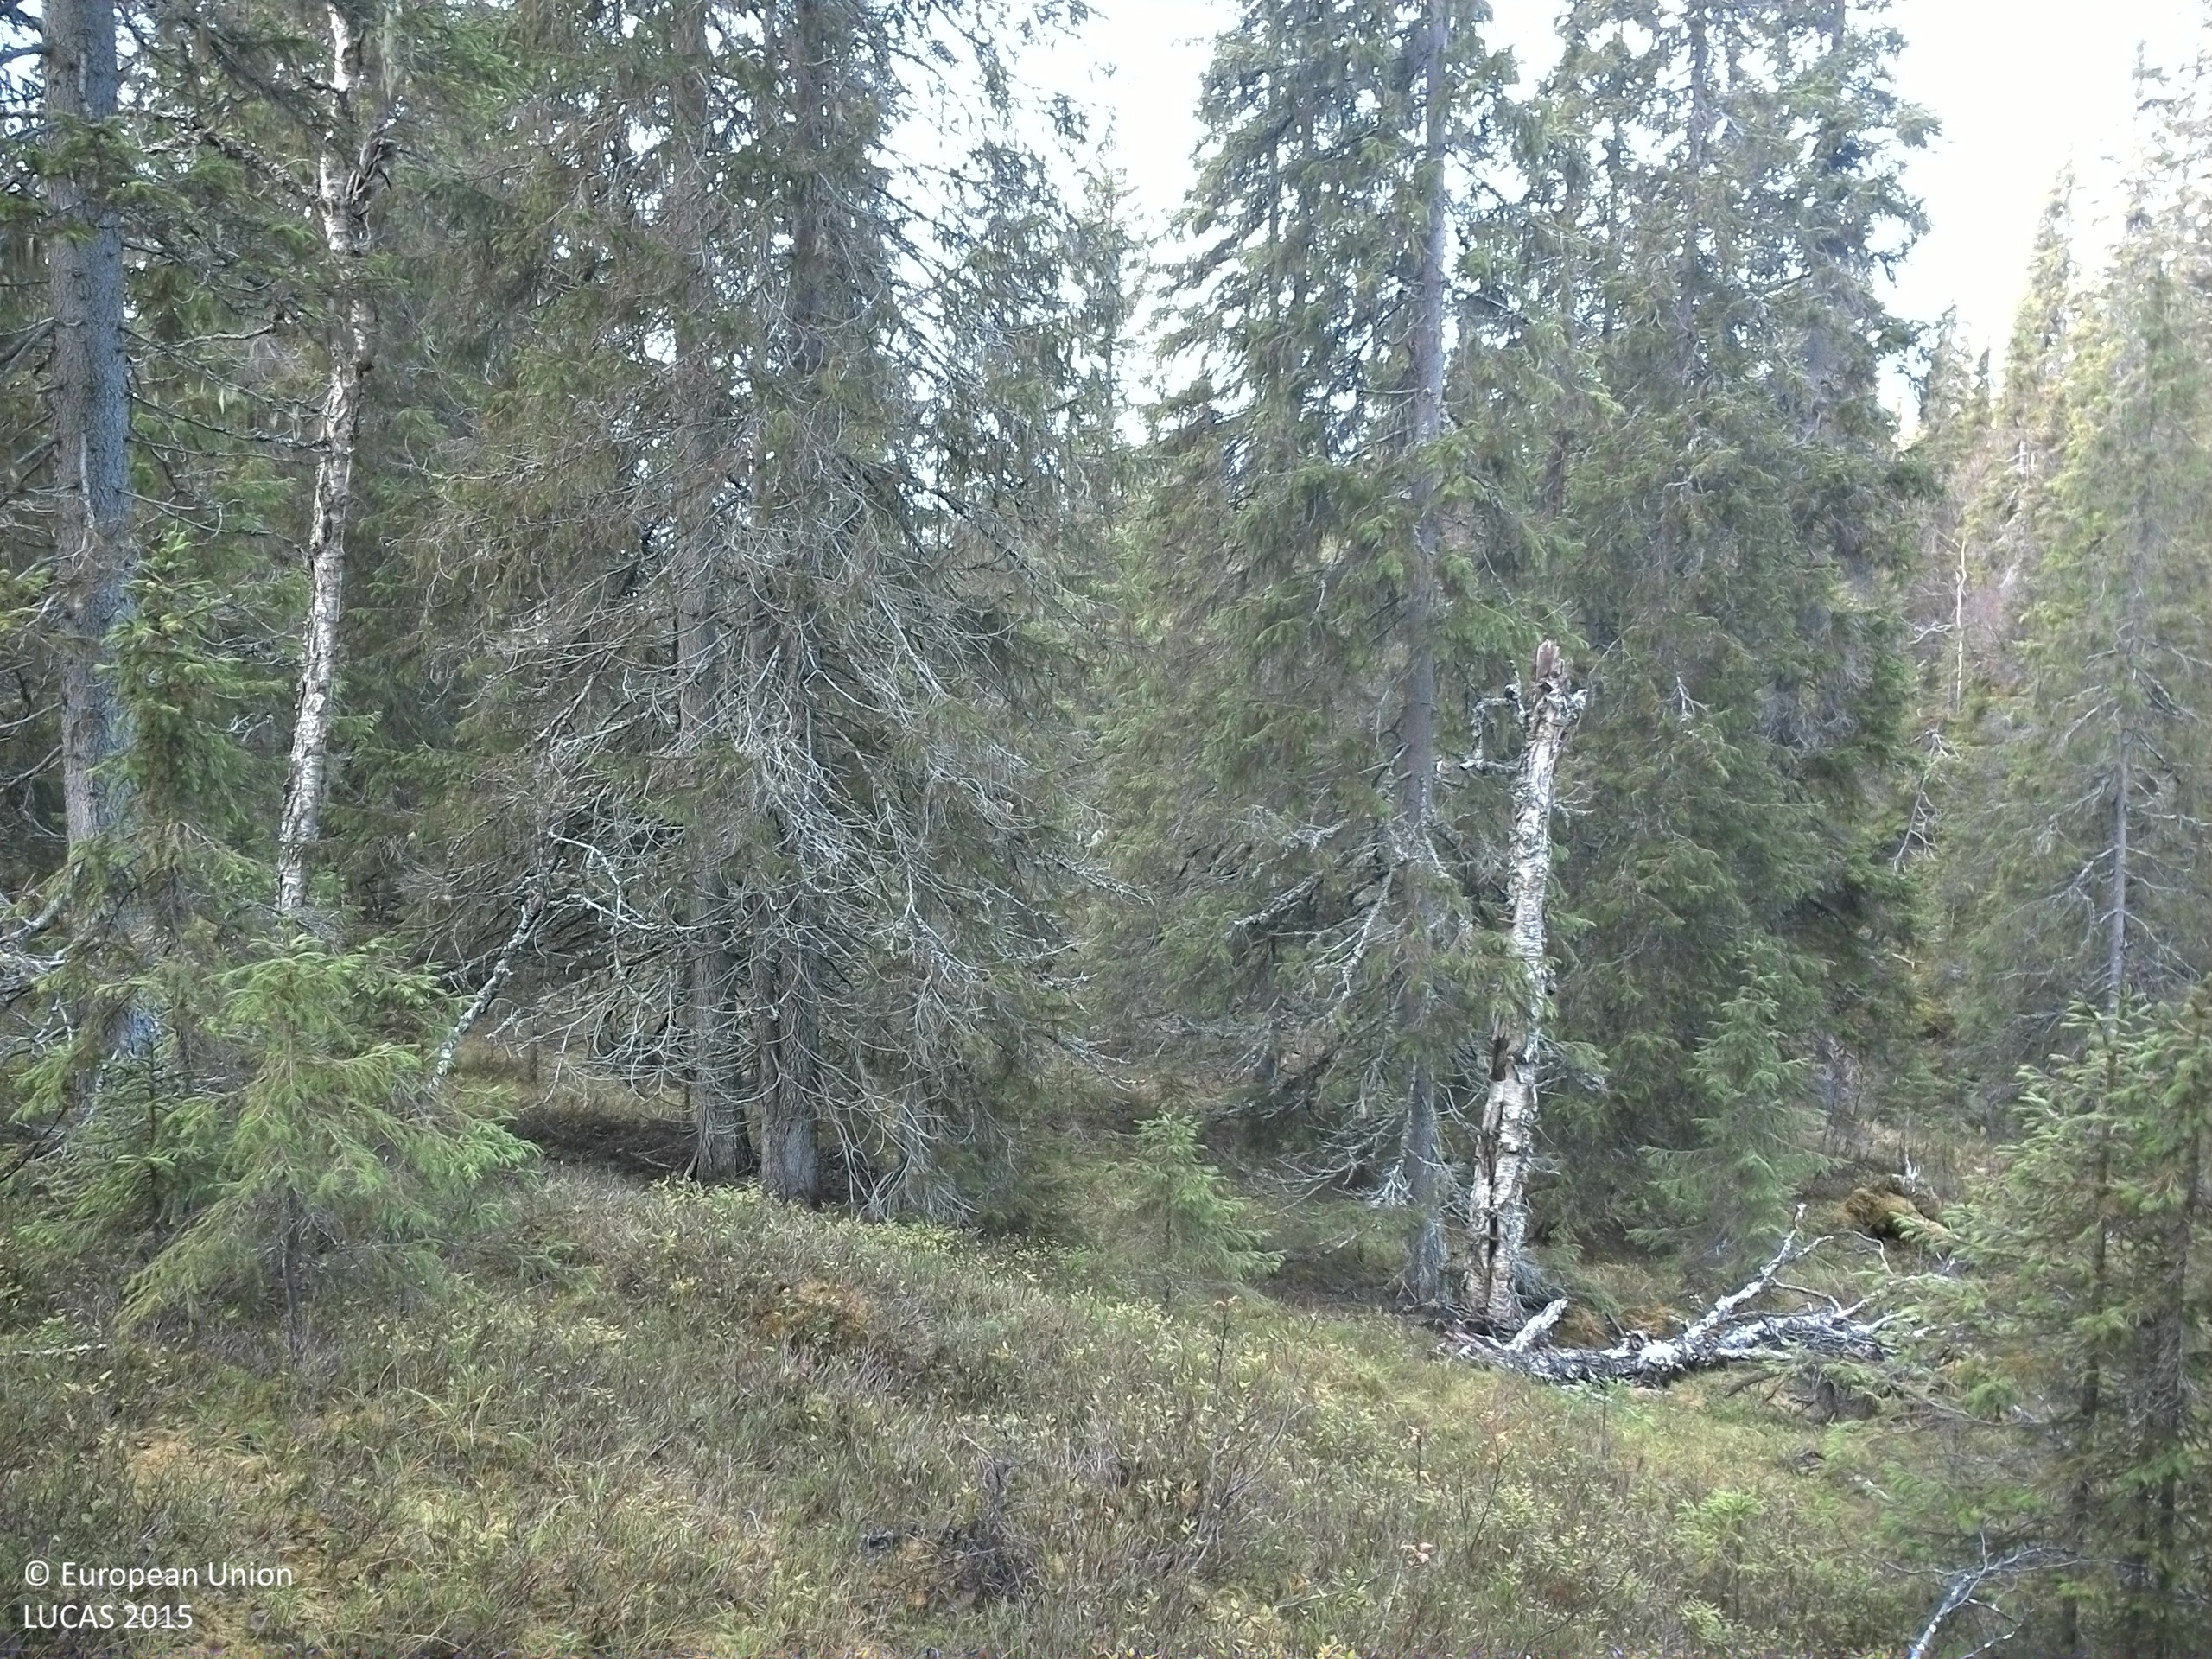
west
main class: Woodland
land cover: Spruce dominated coniferous woodland
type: boreal forest
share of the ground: 25 - 50 %
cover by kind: coniferous forest trees 40 %, shrubs 40 %, lichens and mosses 15 %, broadleaved forest trees 5 %
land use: Forestry
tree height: > 5 m
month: October
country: SE
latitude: 64.6196
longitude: 13.9694
